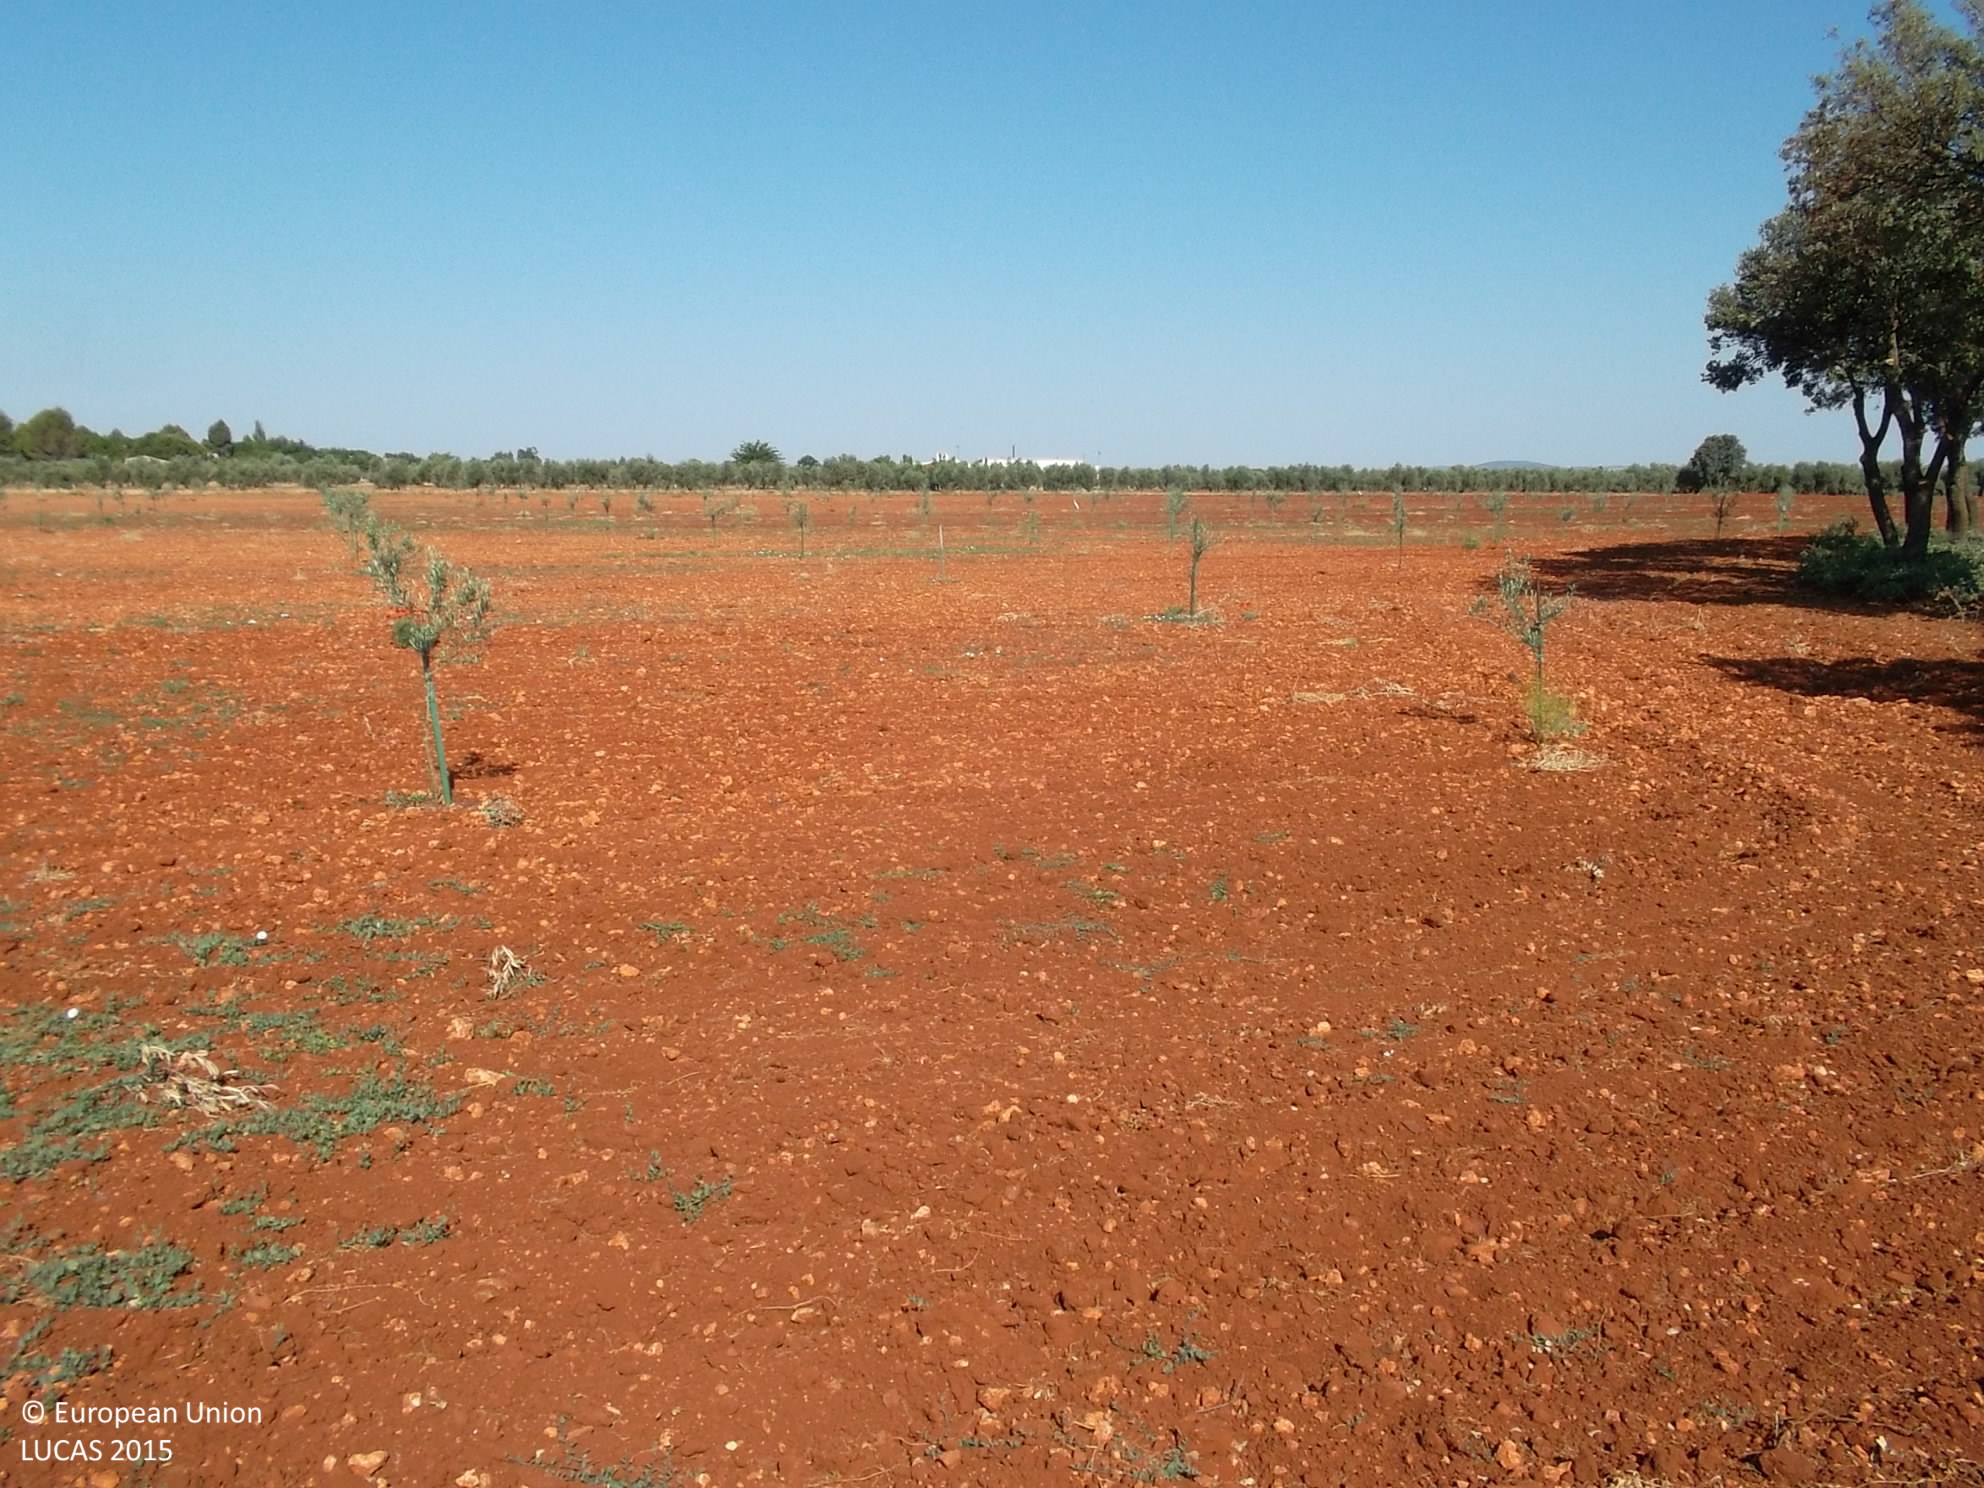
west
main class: Cropland
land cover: Olive groves
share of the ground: 10 - 25 %
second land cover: Other bare soil
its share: > 75 %
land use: Agriculture (excluding fallow land and kitchen gardens)
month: June
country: ES
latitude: 38.7416
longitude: -4.0196
